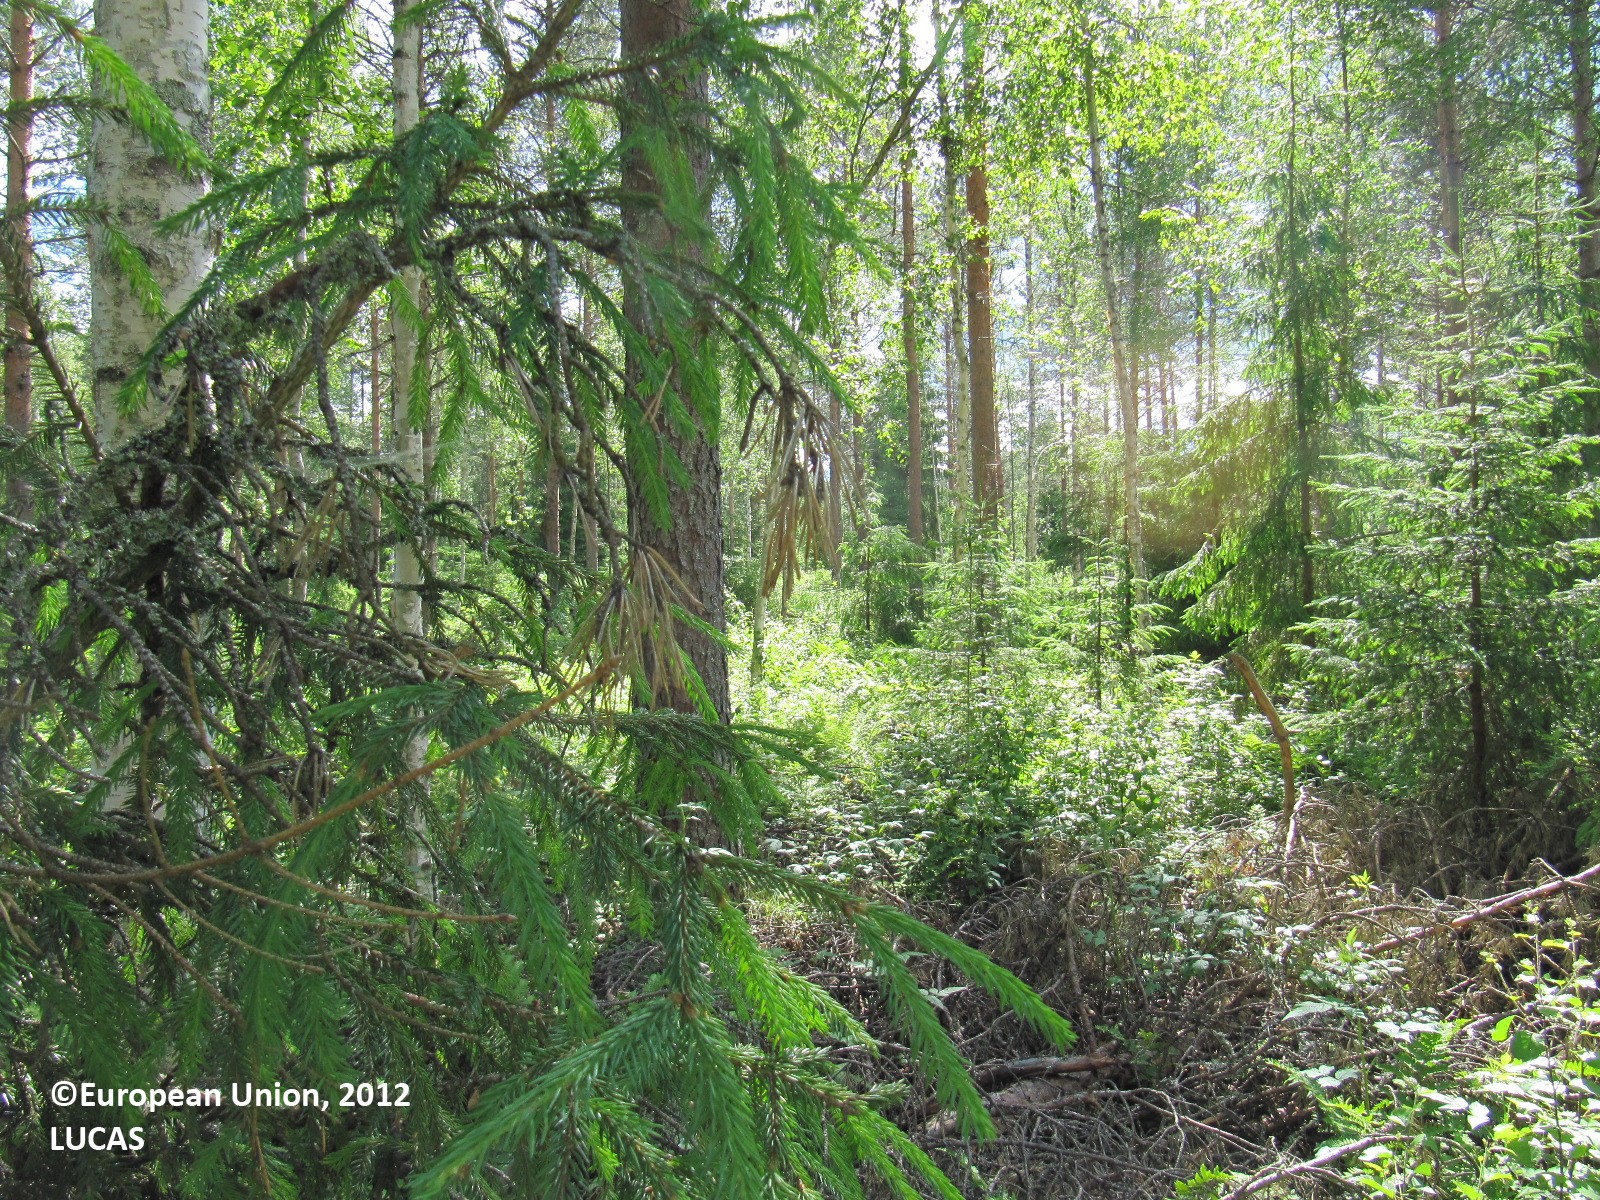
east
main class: Woodland
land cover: Pine dominated mixed woodland
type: boreal forest
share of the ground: > 75 %
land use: Forestry
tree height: > 5 m
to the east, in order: Pine dominated mixed woodland; Tracks; Pine dominated mixed woodland
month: June
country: FI
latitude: 60.6032
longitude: 24.2920
